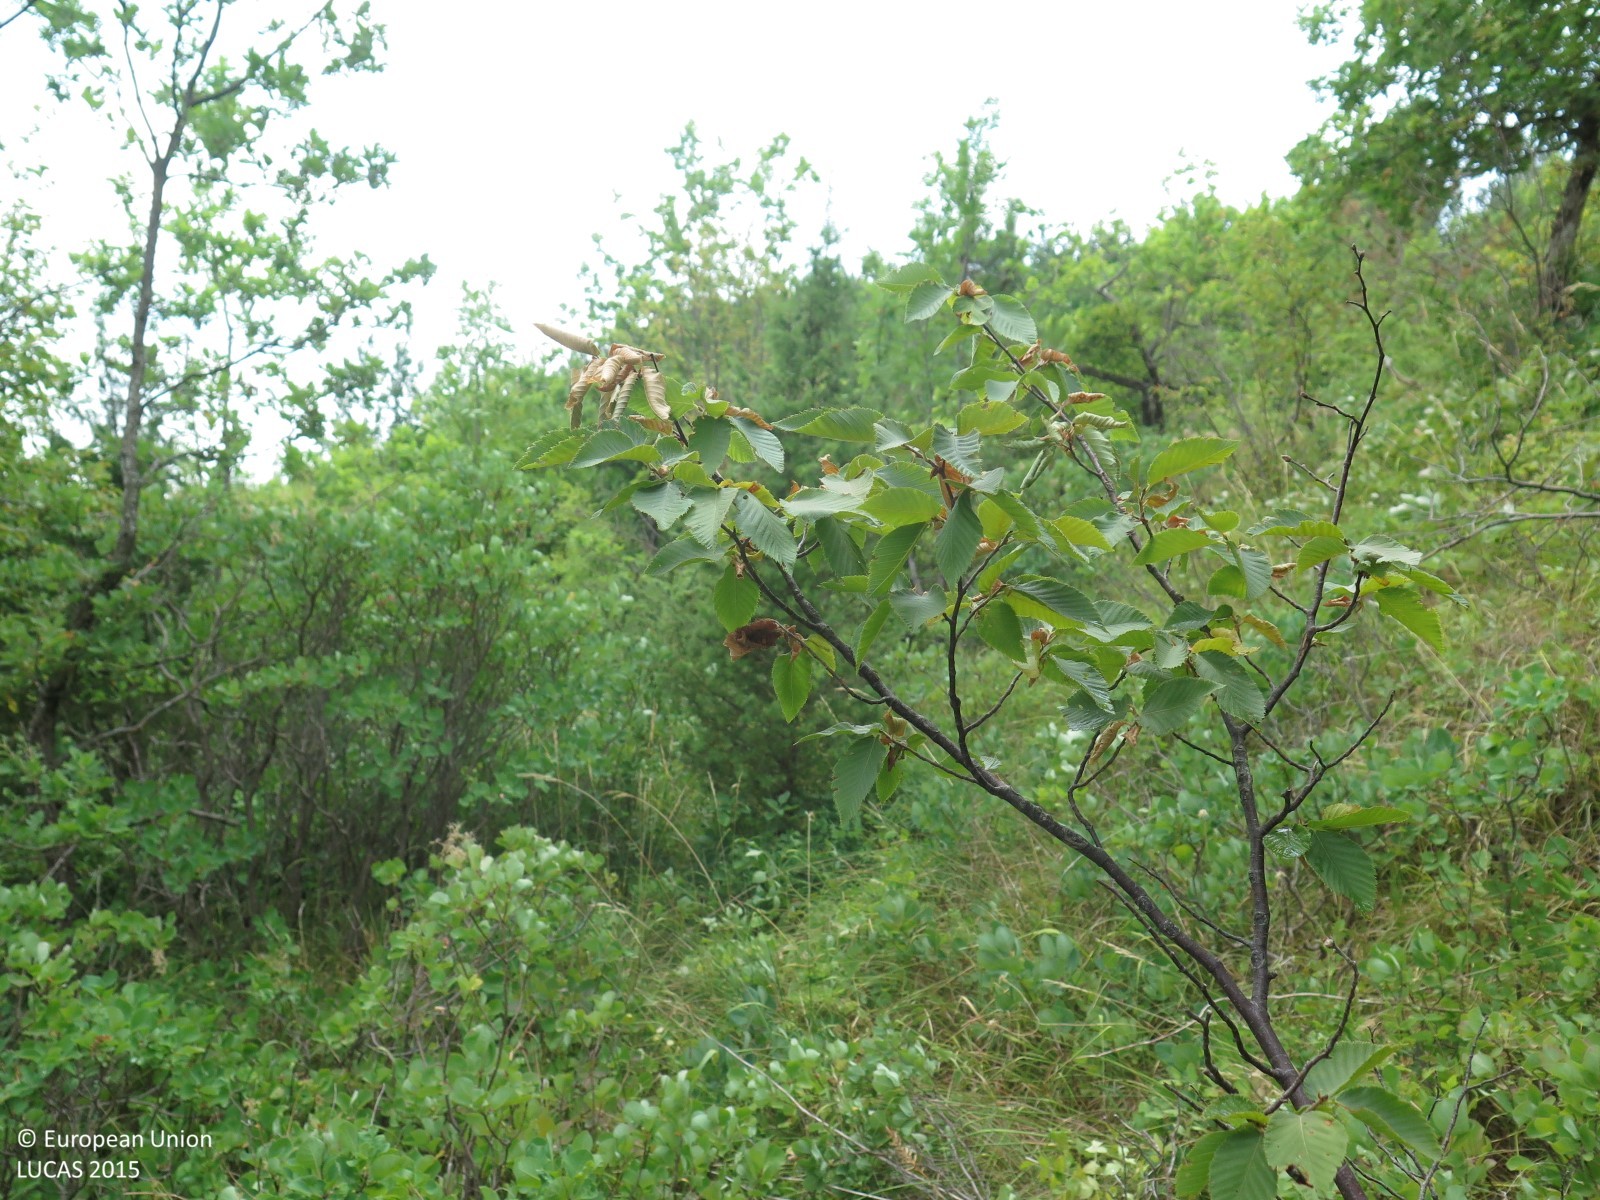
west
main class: Woodland
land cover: Other mixed woodland
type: coniferous forest of the mediterranean region
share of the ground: > 75 %
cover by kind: broadleaved forest trees 75 %, coniferous forest trees 25 %
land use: Semi-natural and natural areas not in use
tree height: < 5 m
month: July
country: HR
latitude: 45.2460
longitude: 14.0590
